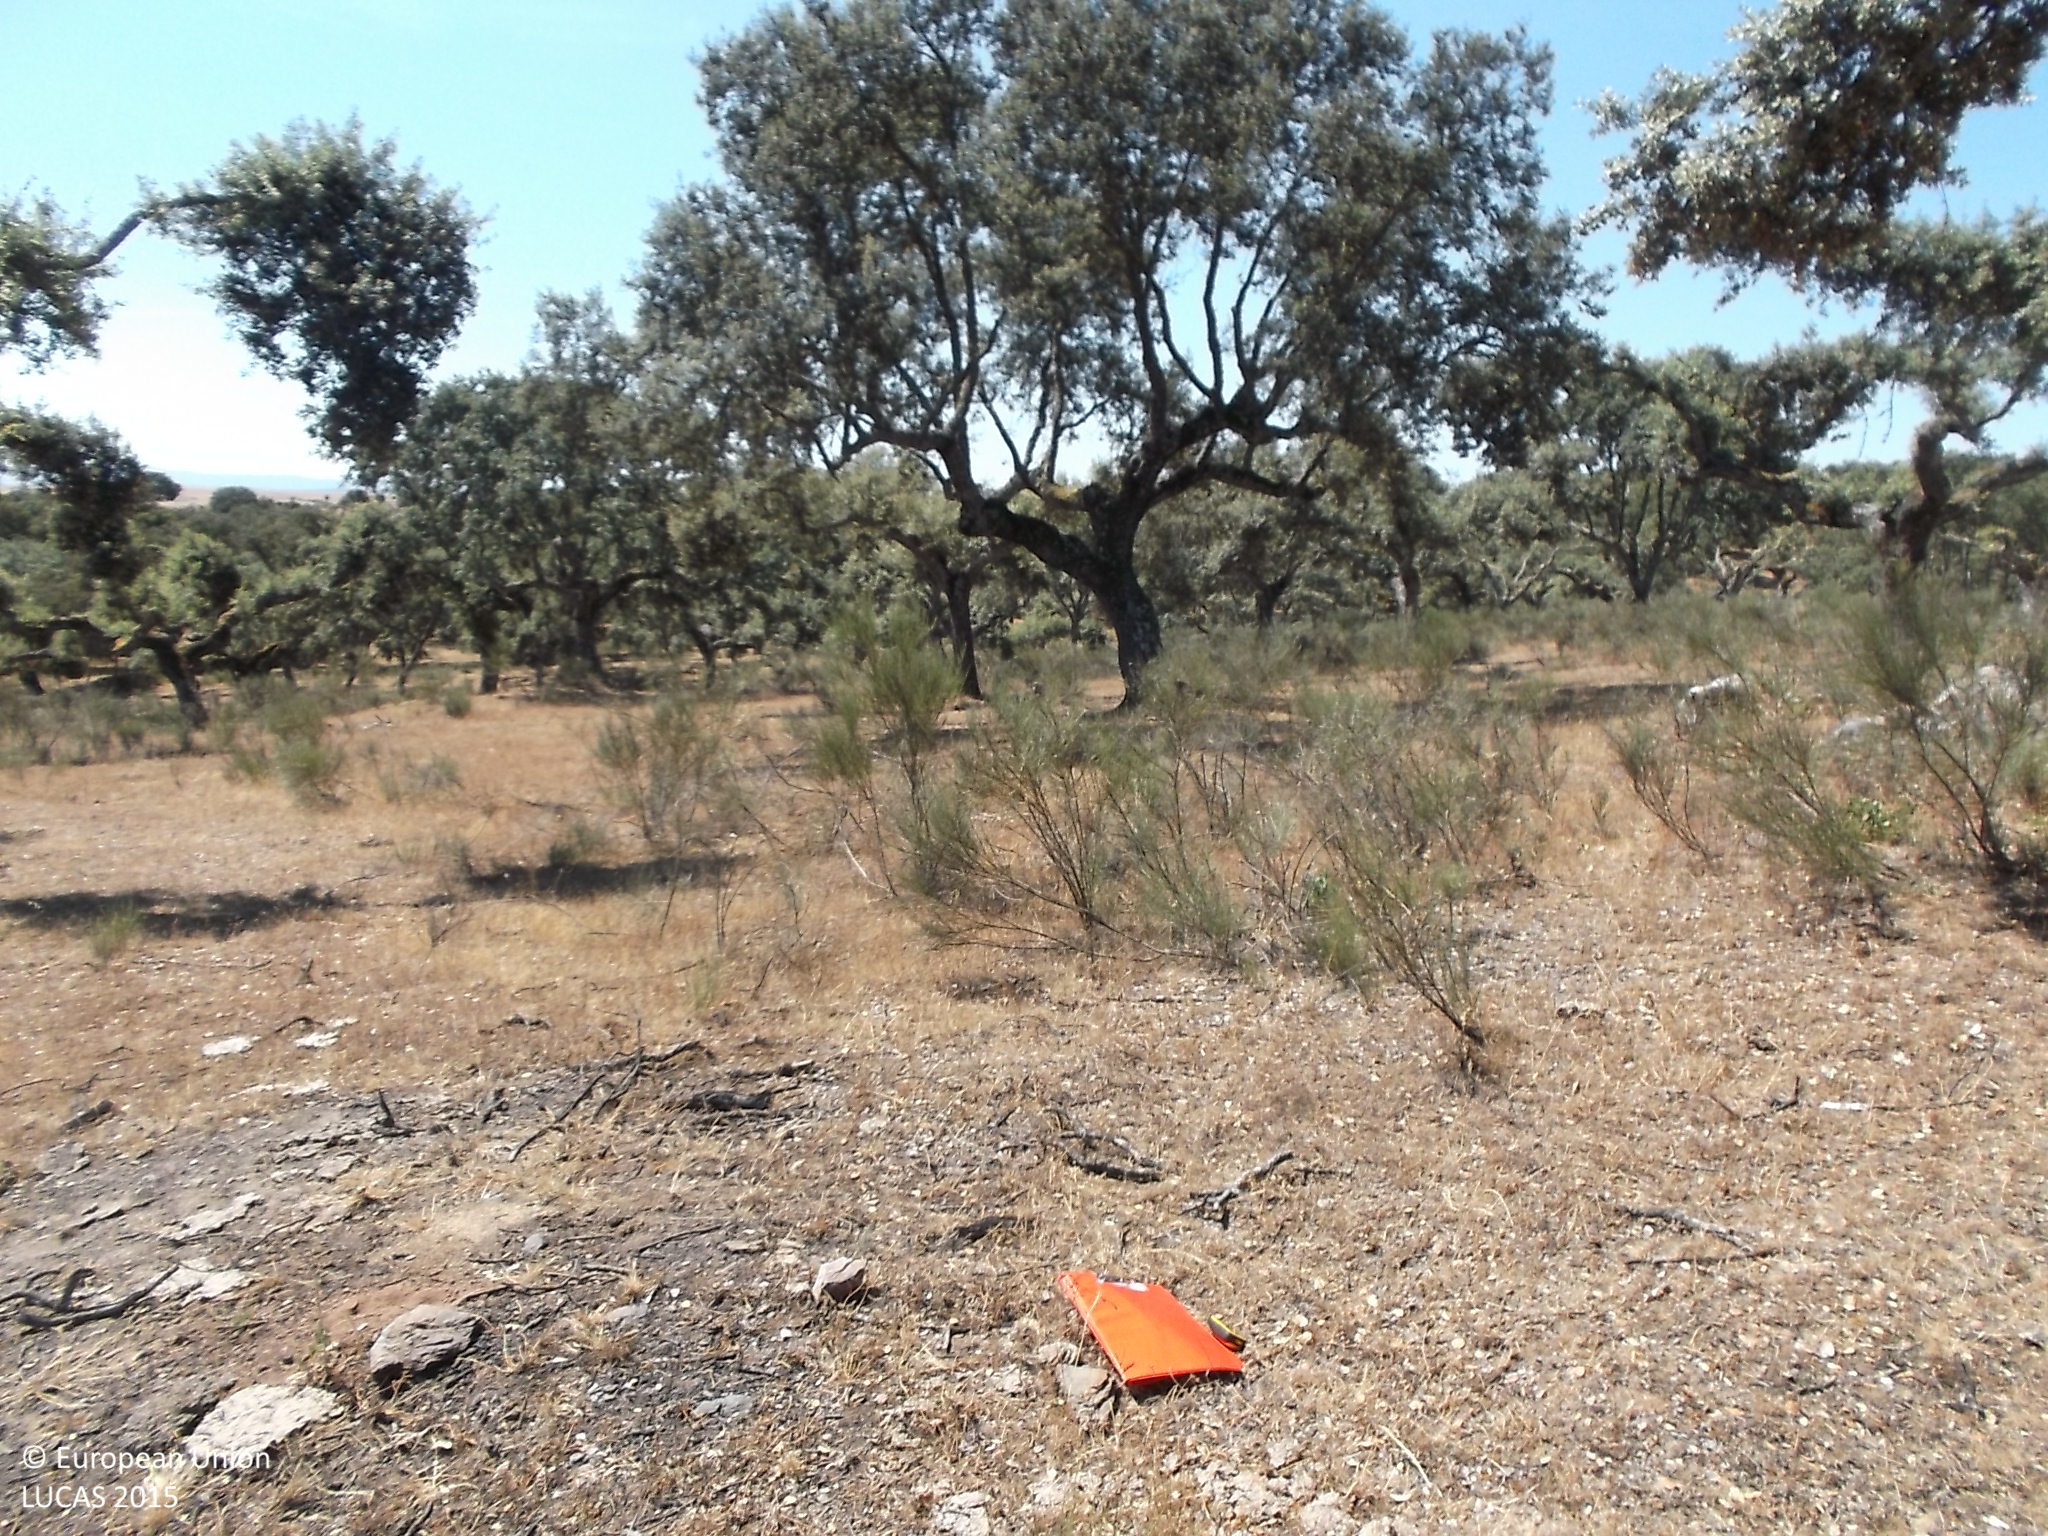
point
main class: Woodland
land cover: Broadleaved woodland
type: broadleaved evergreen forest
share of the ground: 50 - 75 %
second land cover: Shrubland without tree cover
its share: 10 - 25 %
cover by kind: broadleaved forest trees 60 %, shrubs 20 %, herbaceous plants 20 %
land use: Forestry
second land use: Agriculture (excluding fallow land and kitchen gardens)
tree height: < 5 m
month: July
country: ES
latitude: 40.6469
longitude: -6.7095
